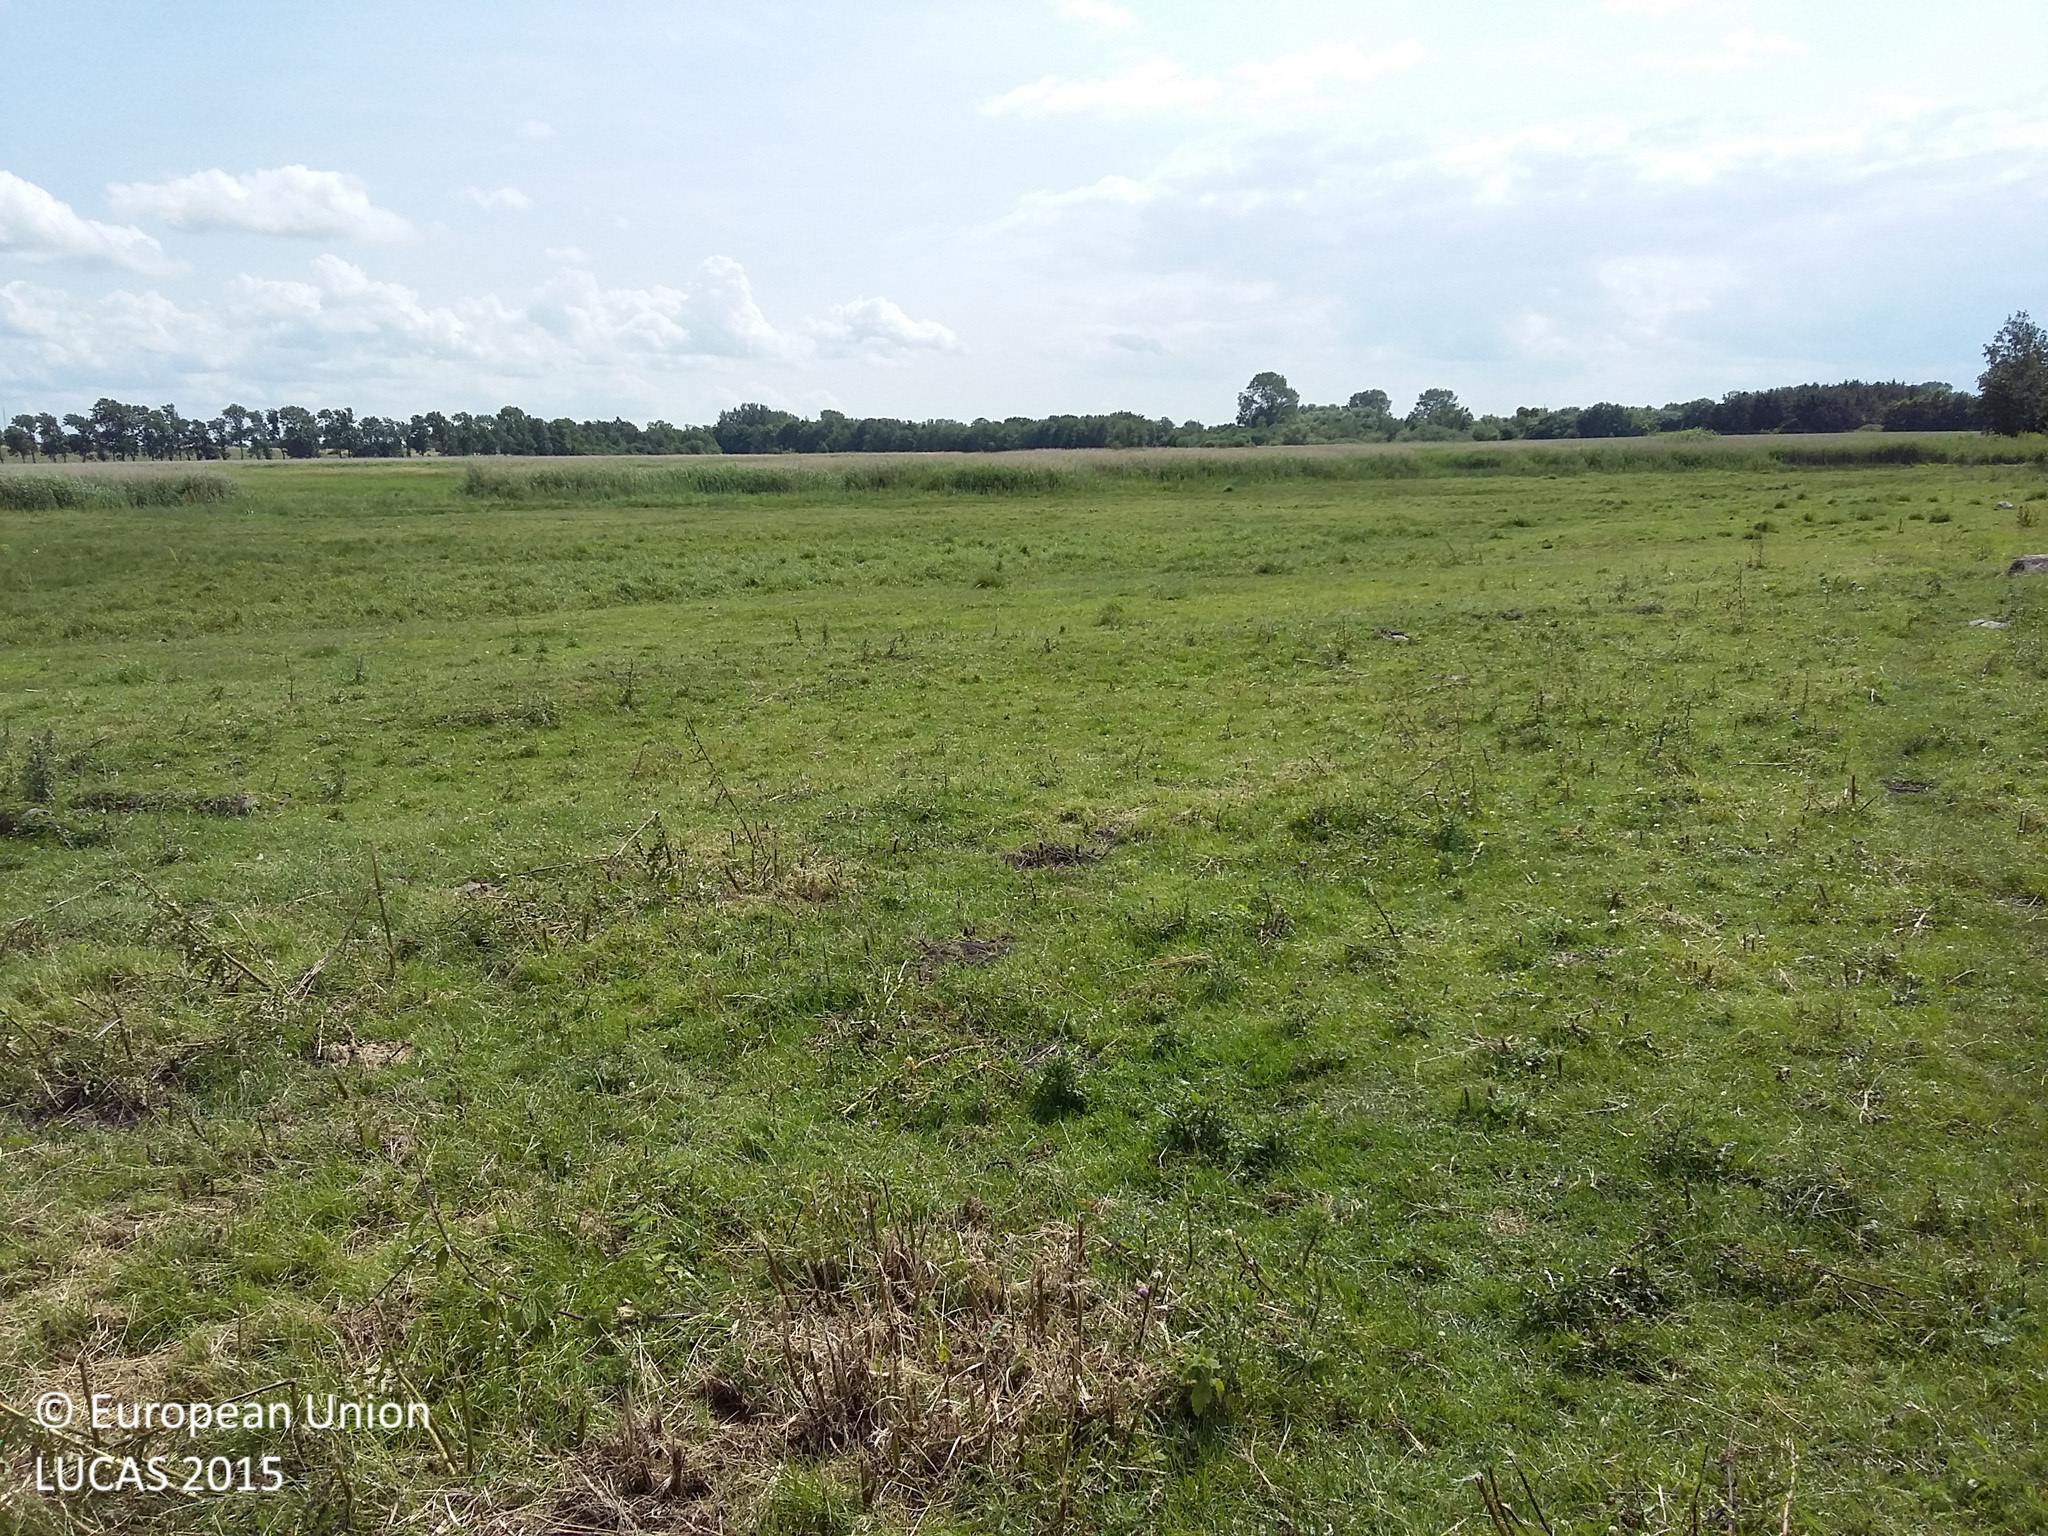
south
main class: Grassland
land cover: Grassland without tree/shrub cover
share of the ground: > 75 %
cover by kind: herbaceous plants 100 %
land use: Agriculture (excluding fallow land and kitchen gardens)
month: July
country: DK
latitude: 55.5345
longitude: 11.2506
